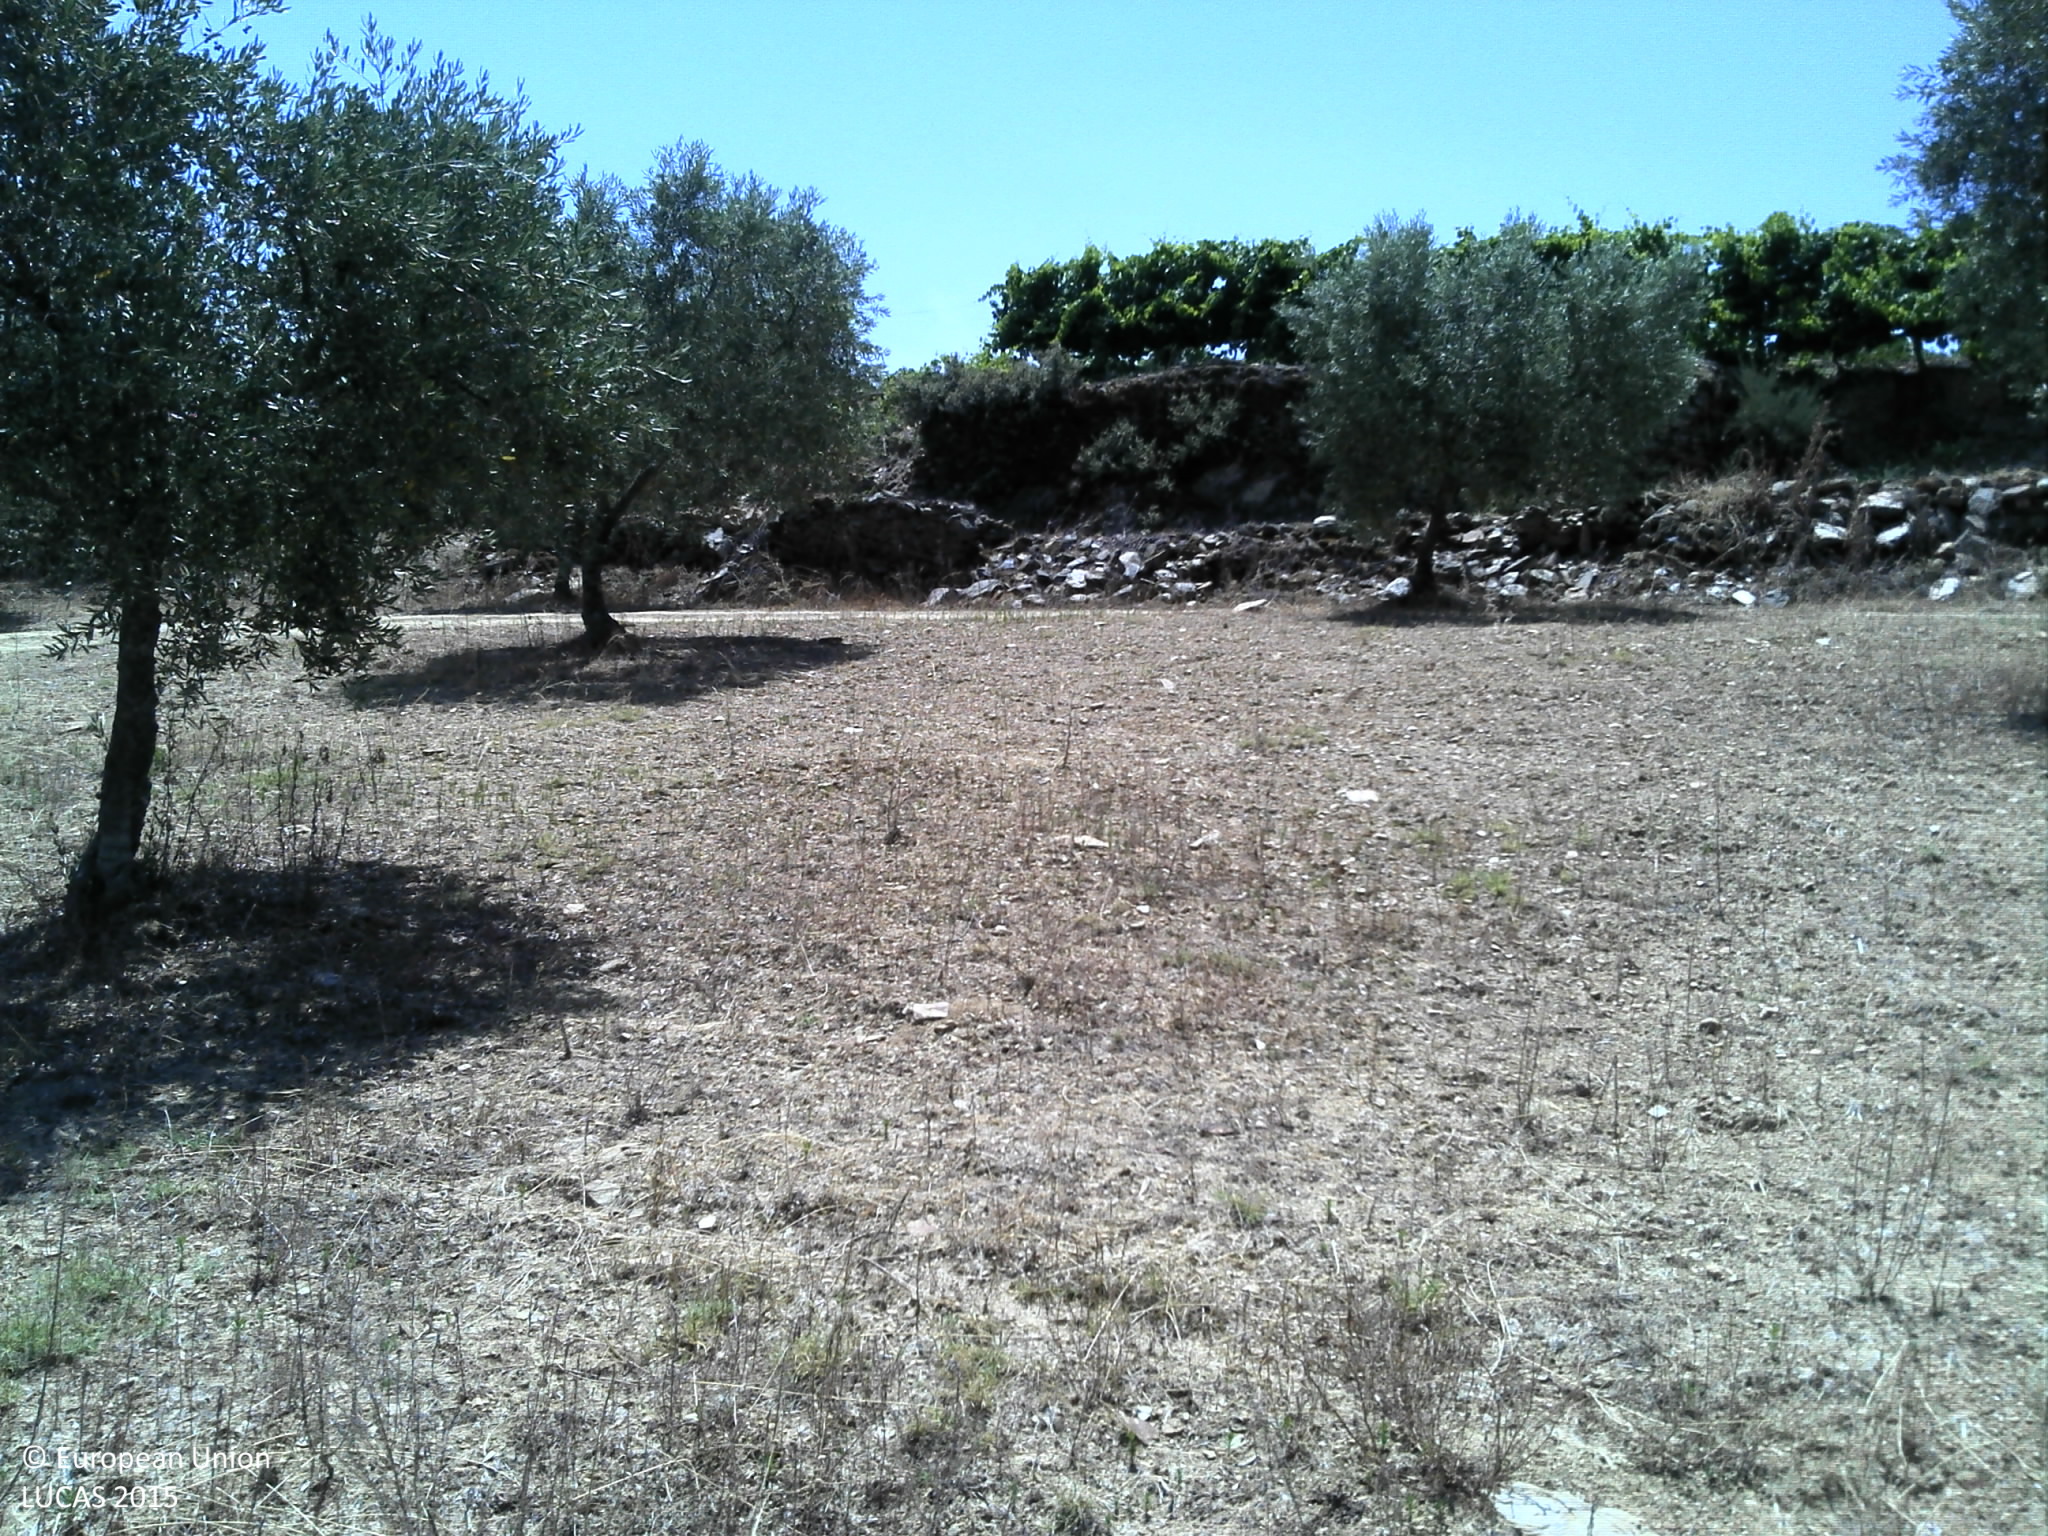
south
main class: Cropland
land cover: Olive groves
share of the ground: 25 - 50 %
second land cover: Grassland without tree/shrub cover
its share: < 10 %
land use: Agriculture (excluding fallow land and kitchen gardens)
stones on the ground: 10 - 25 %
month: July
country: PT
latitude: 41.0902
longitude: -7.4406
